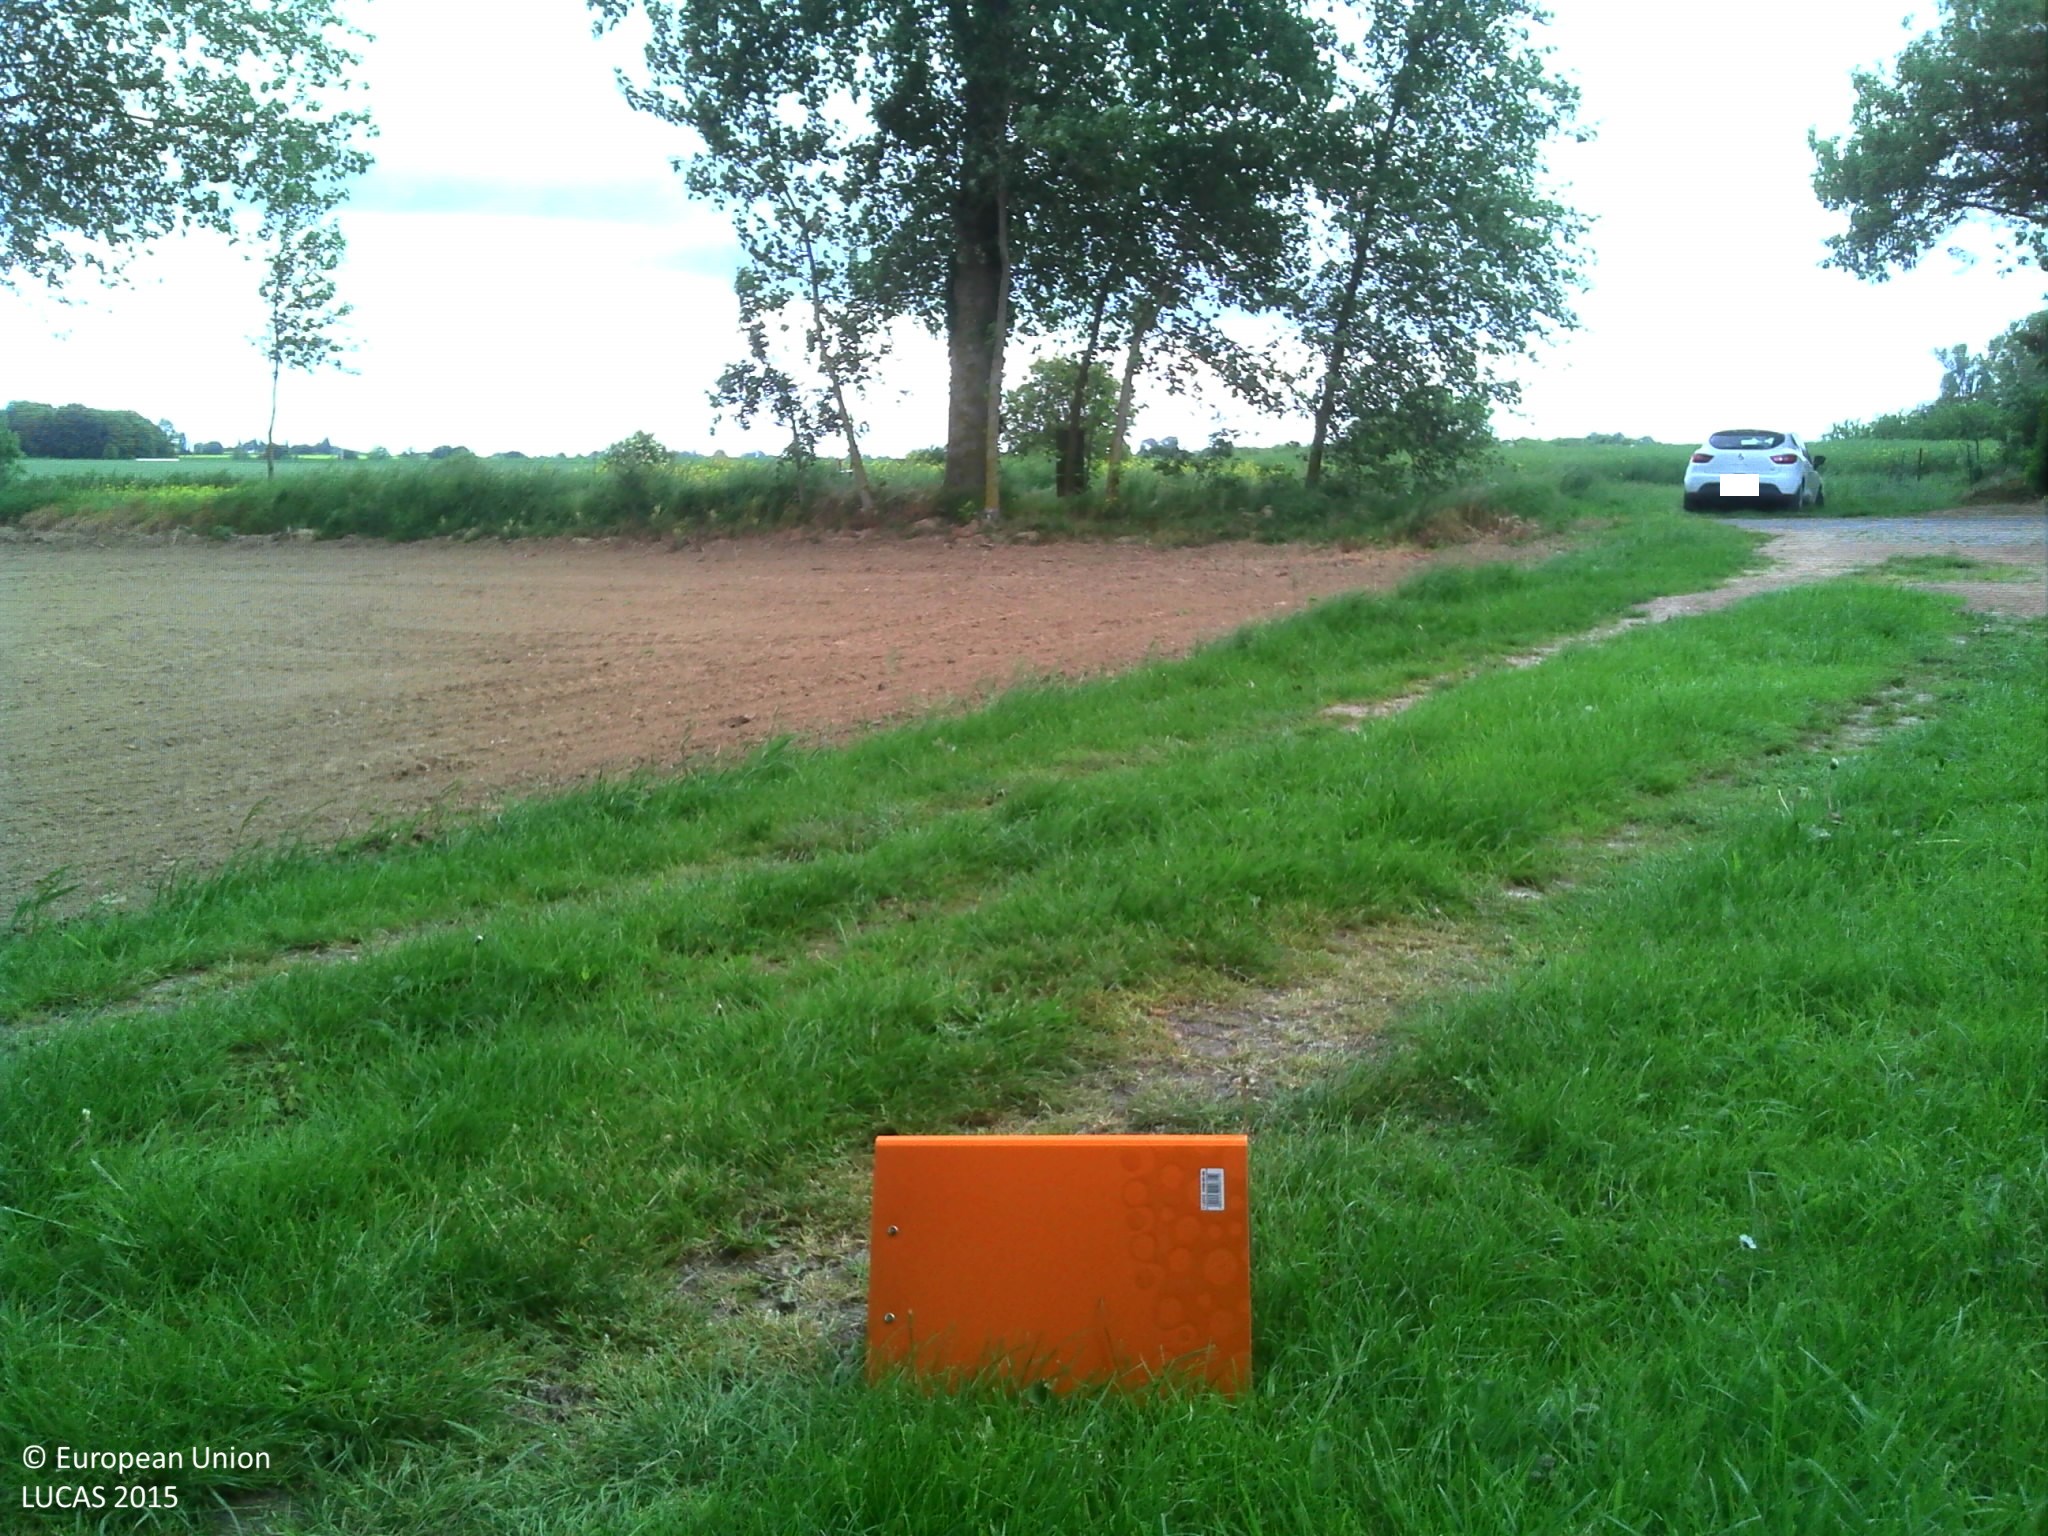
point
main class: Grassland
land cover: Grassland with sparse tree/shrub cover
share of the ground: > 75 %
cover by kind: herbaceous plants 95 %, broadleaved forest trees 5 %
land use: Residential
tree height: > 5 m
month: May
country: FR
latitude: 49.8380
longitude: 3.2200
